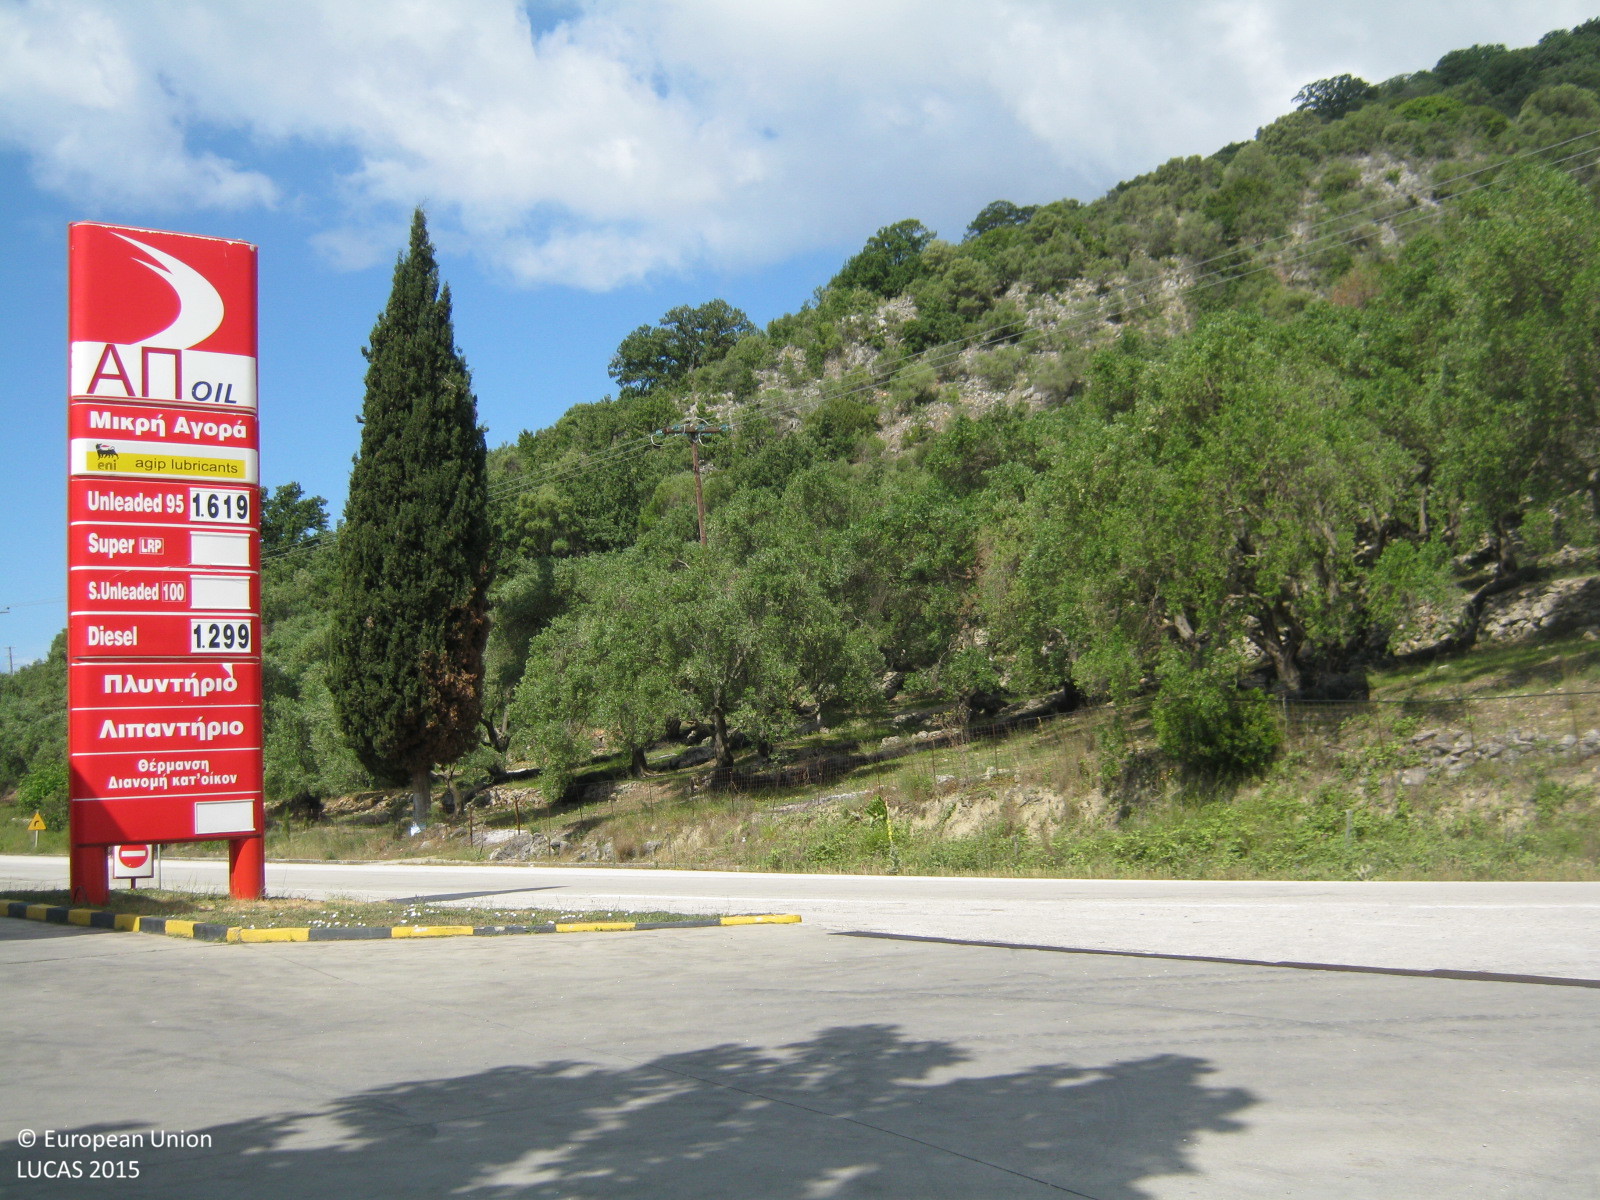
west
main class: Shrubland
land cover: Shrubland with sparse tree cover
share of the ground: > 75 %
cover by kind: shrubs 95 %, broadleaved forest trees 5 %
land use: Semi-natural and natural areas not in use
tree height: > 5 m
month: May
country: GR
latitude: 39.2867
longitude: 20.4647
